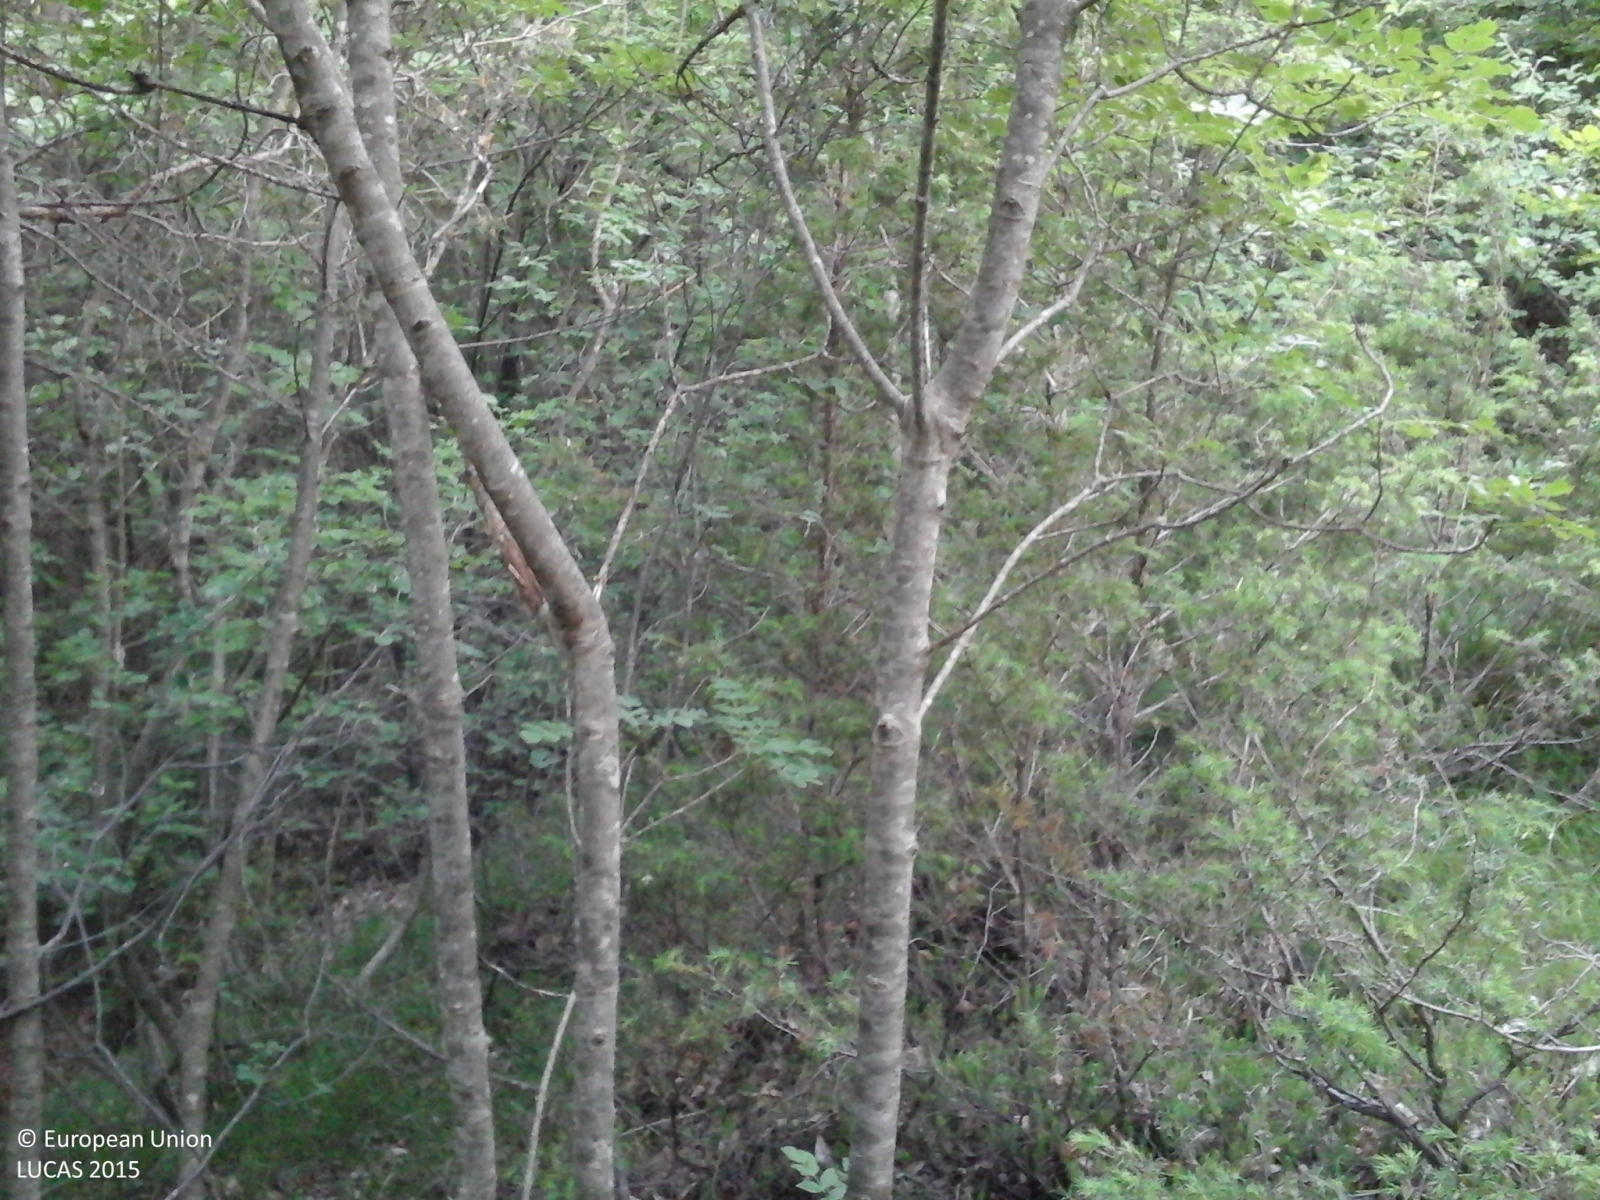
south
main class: Woodland
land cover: Broadleaved woodland
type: mountainous beech forest
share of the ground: > 75 %
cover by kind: broadleaved forest trees 100 %
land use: Forestry
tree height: > 5 m
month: June
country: IT
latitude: 45.9865
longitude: 10.9668
